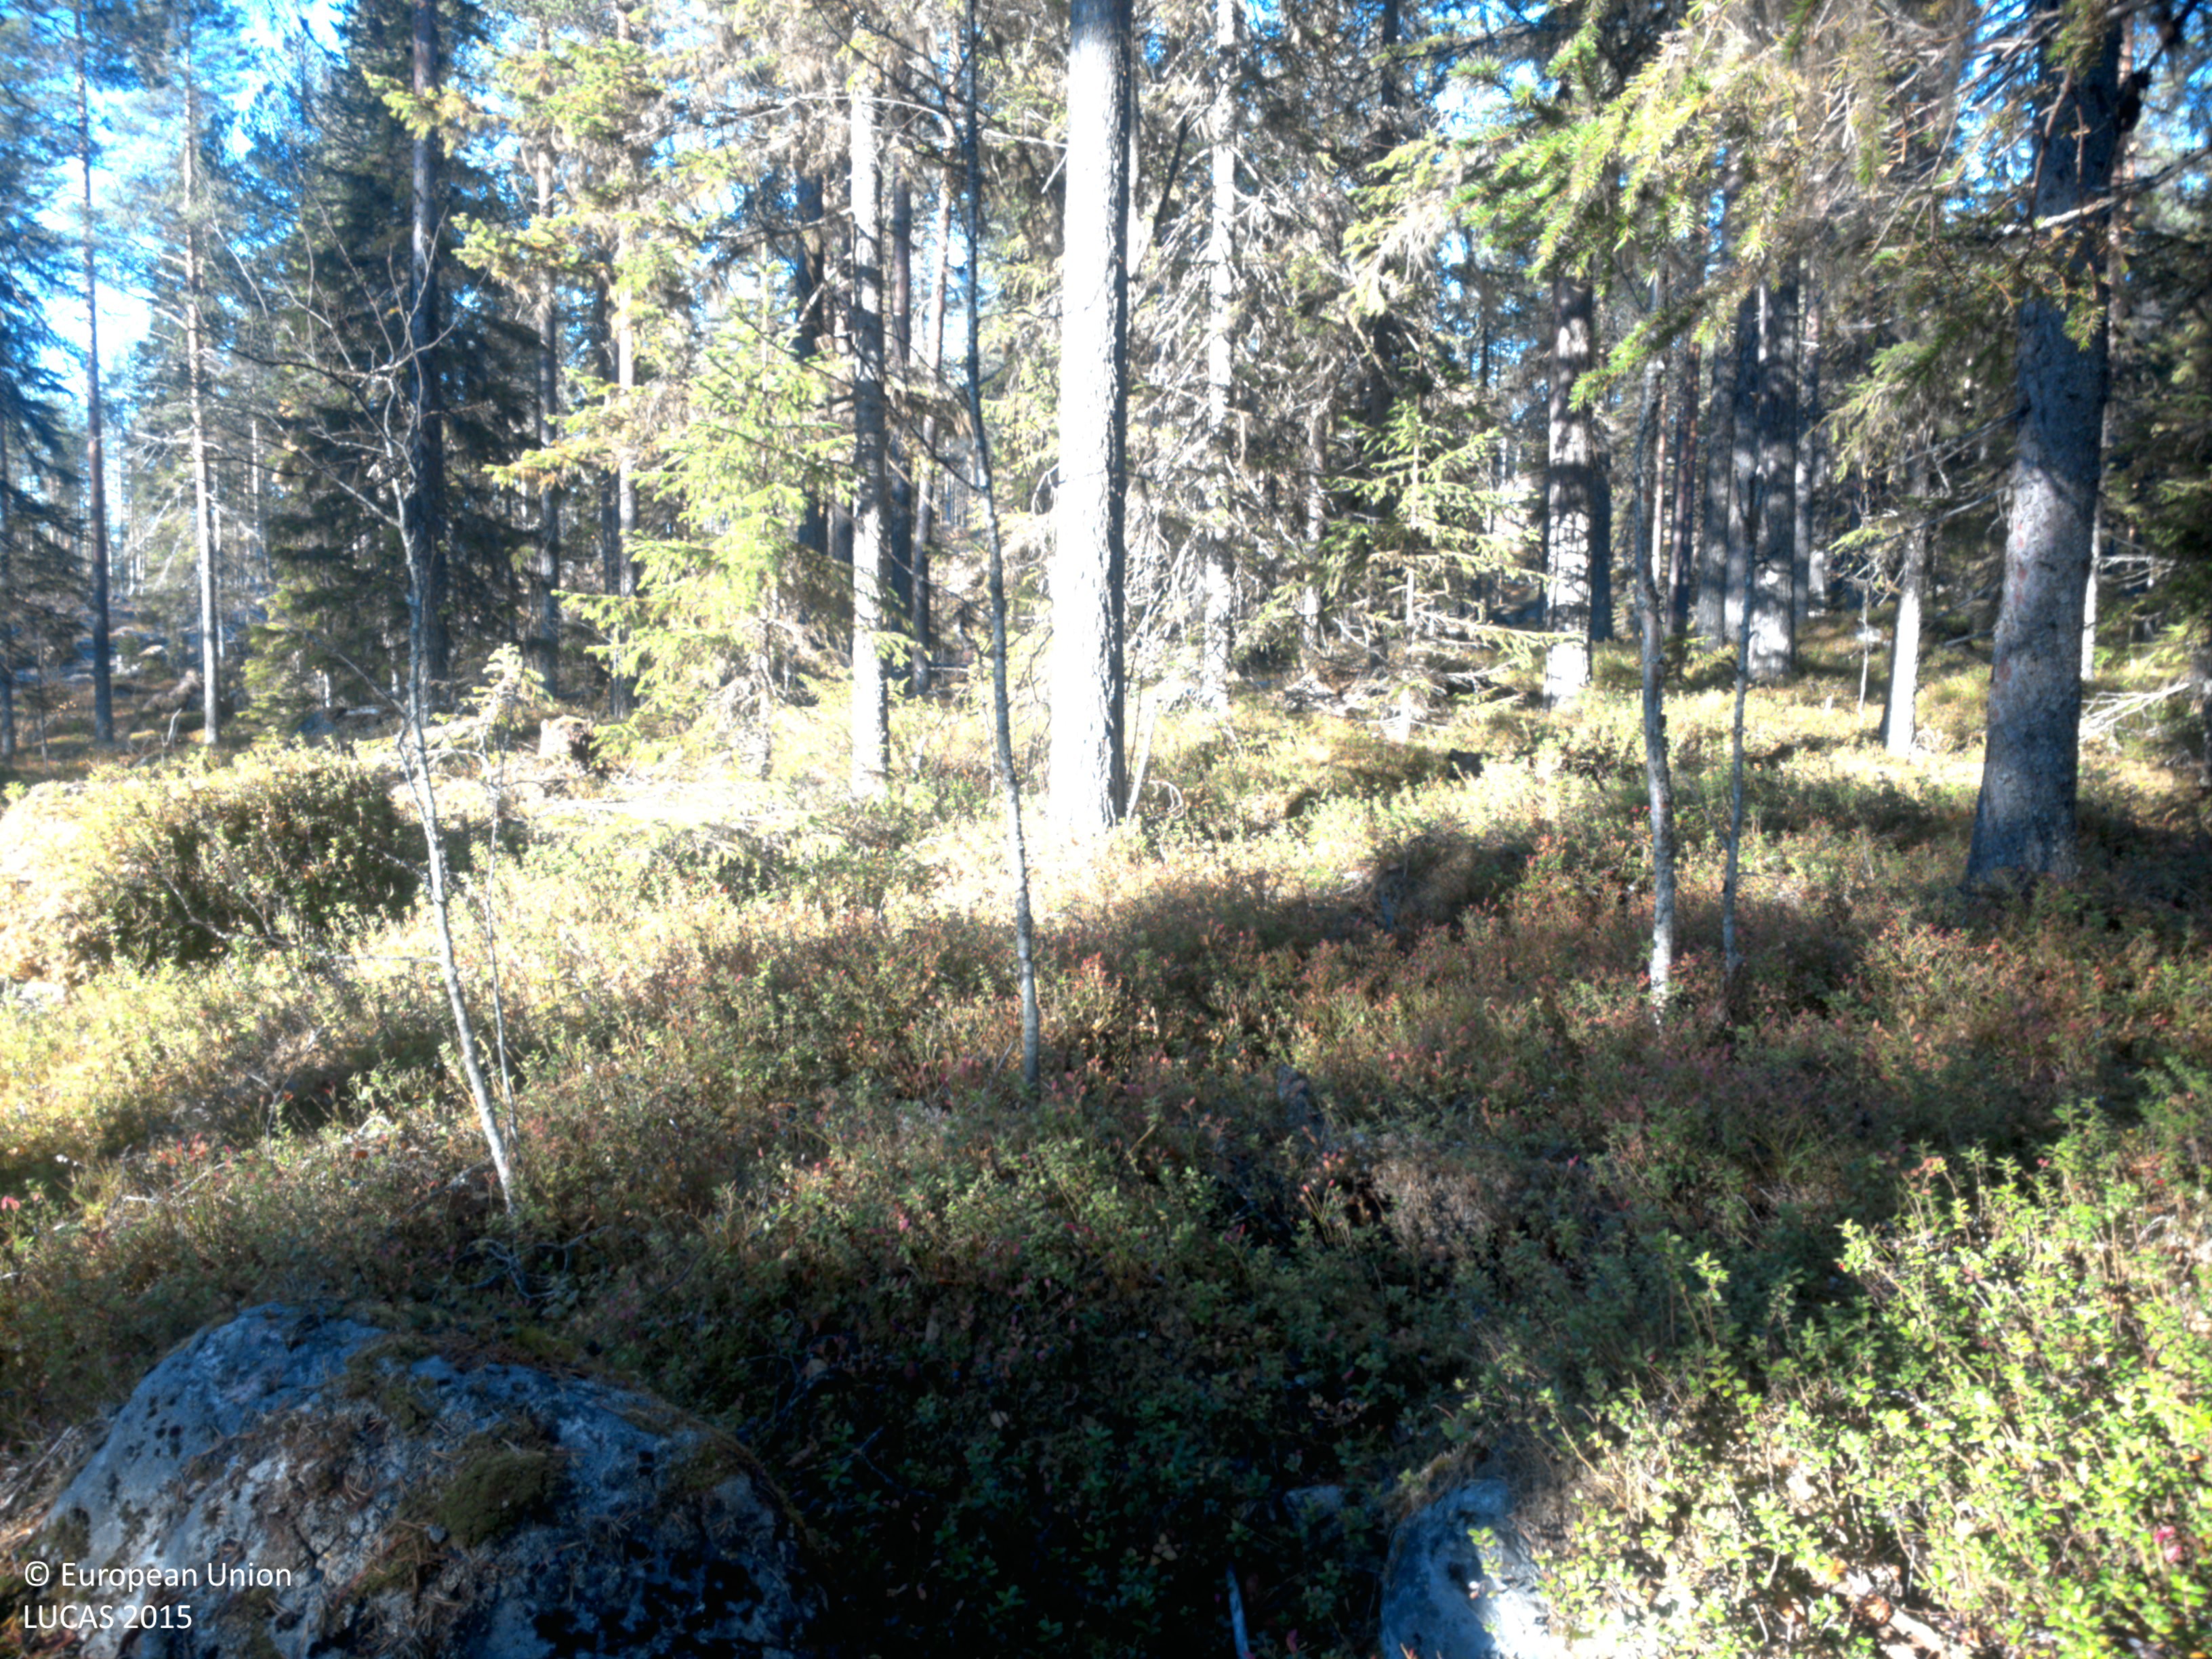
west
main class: Woodland
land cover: Other coniferous woodland
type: boreal forest
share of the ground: 50 - 75 %
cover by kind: coniferous forest trees 65 %, shrubs 20 %, lichens and mosses 10 %, herbaceous plants 5 %
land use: Forestry
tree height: > 5 m
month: October
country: SE
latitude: 64.7618
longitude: 18.3108
